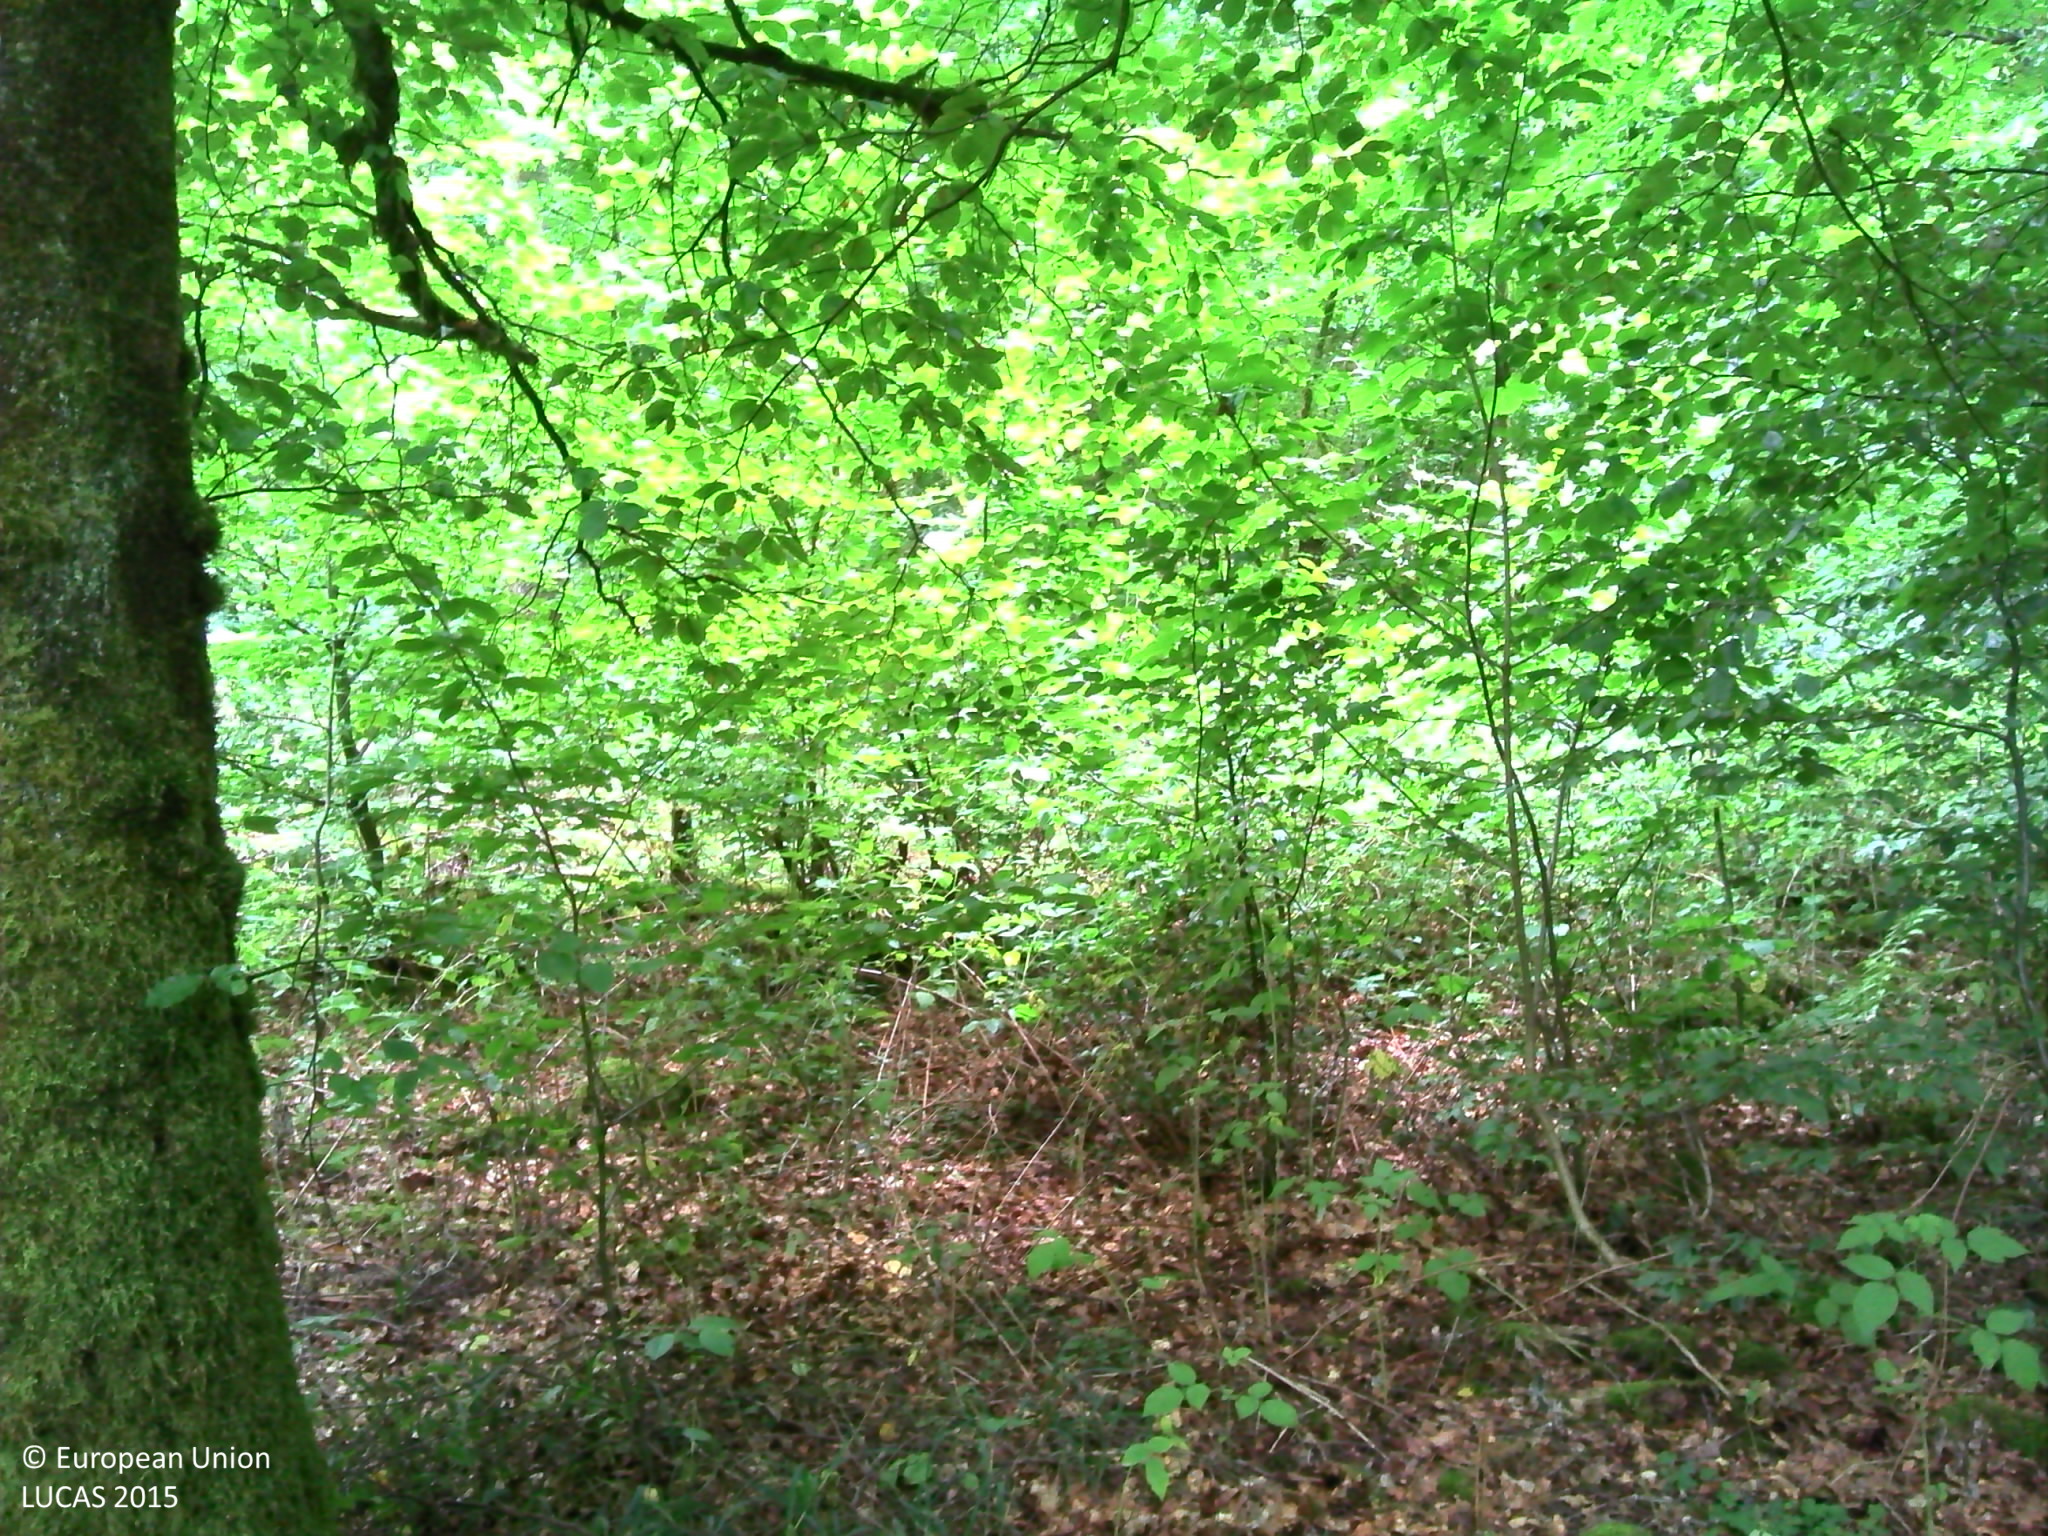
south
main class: Woodland
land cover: Broadleaved woodland
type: acidophilous oak and oak-birch forest
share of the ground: > 75 %
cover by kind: broadleaved forest trees 80 %, shrubs 10 %, herbaceous plants 10 %
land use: Forestry
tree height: > 5 m
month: July
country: BE
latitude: 49.6505
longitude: 5.6357
